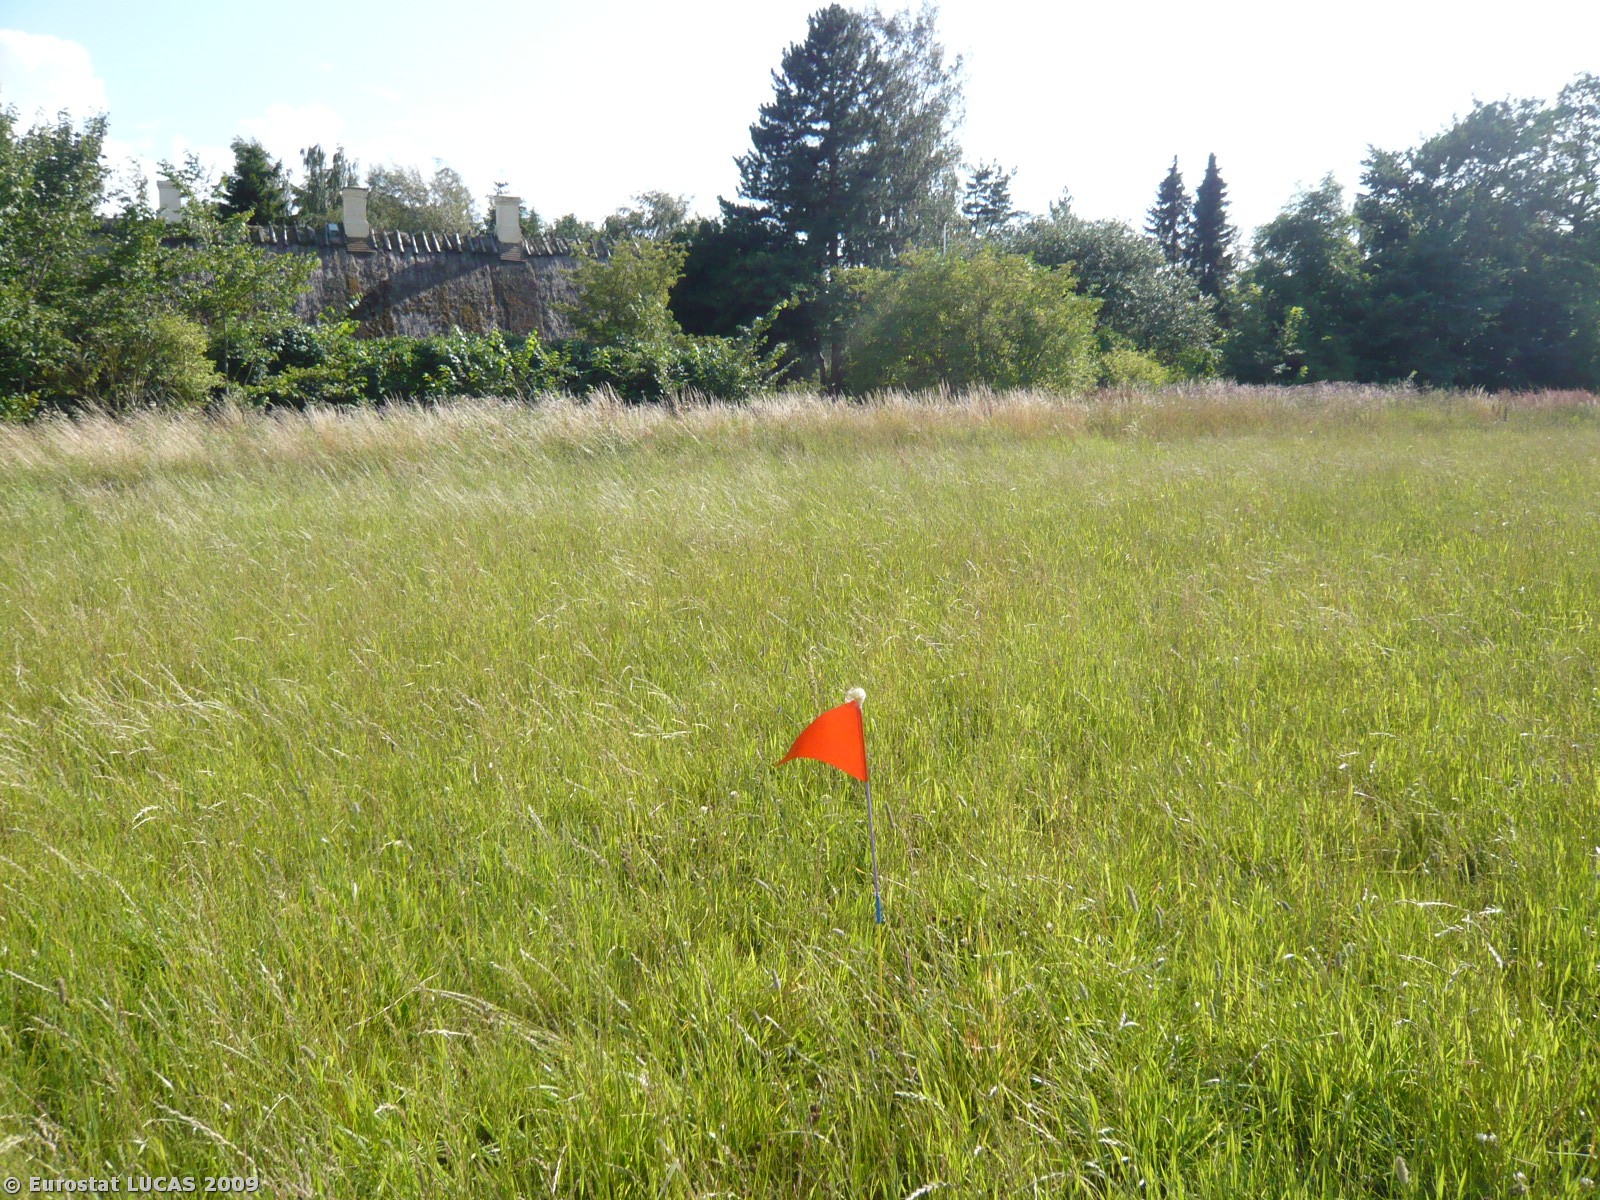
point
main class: Cropland
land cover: Temporary grasslands
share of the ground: > 75 %
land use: Agriculture (excluding fallow land and kitchen gardens)
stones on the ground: < 10 %
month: July
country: DK
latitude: 55.8977
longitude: 12.2849
